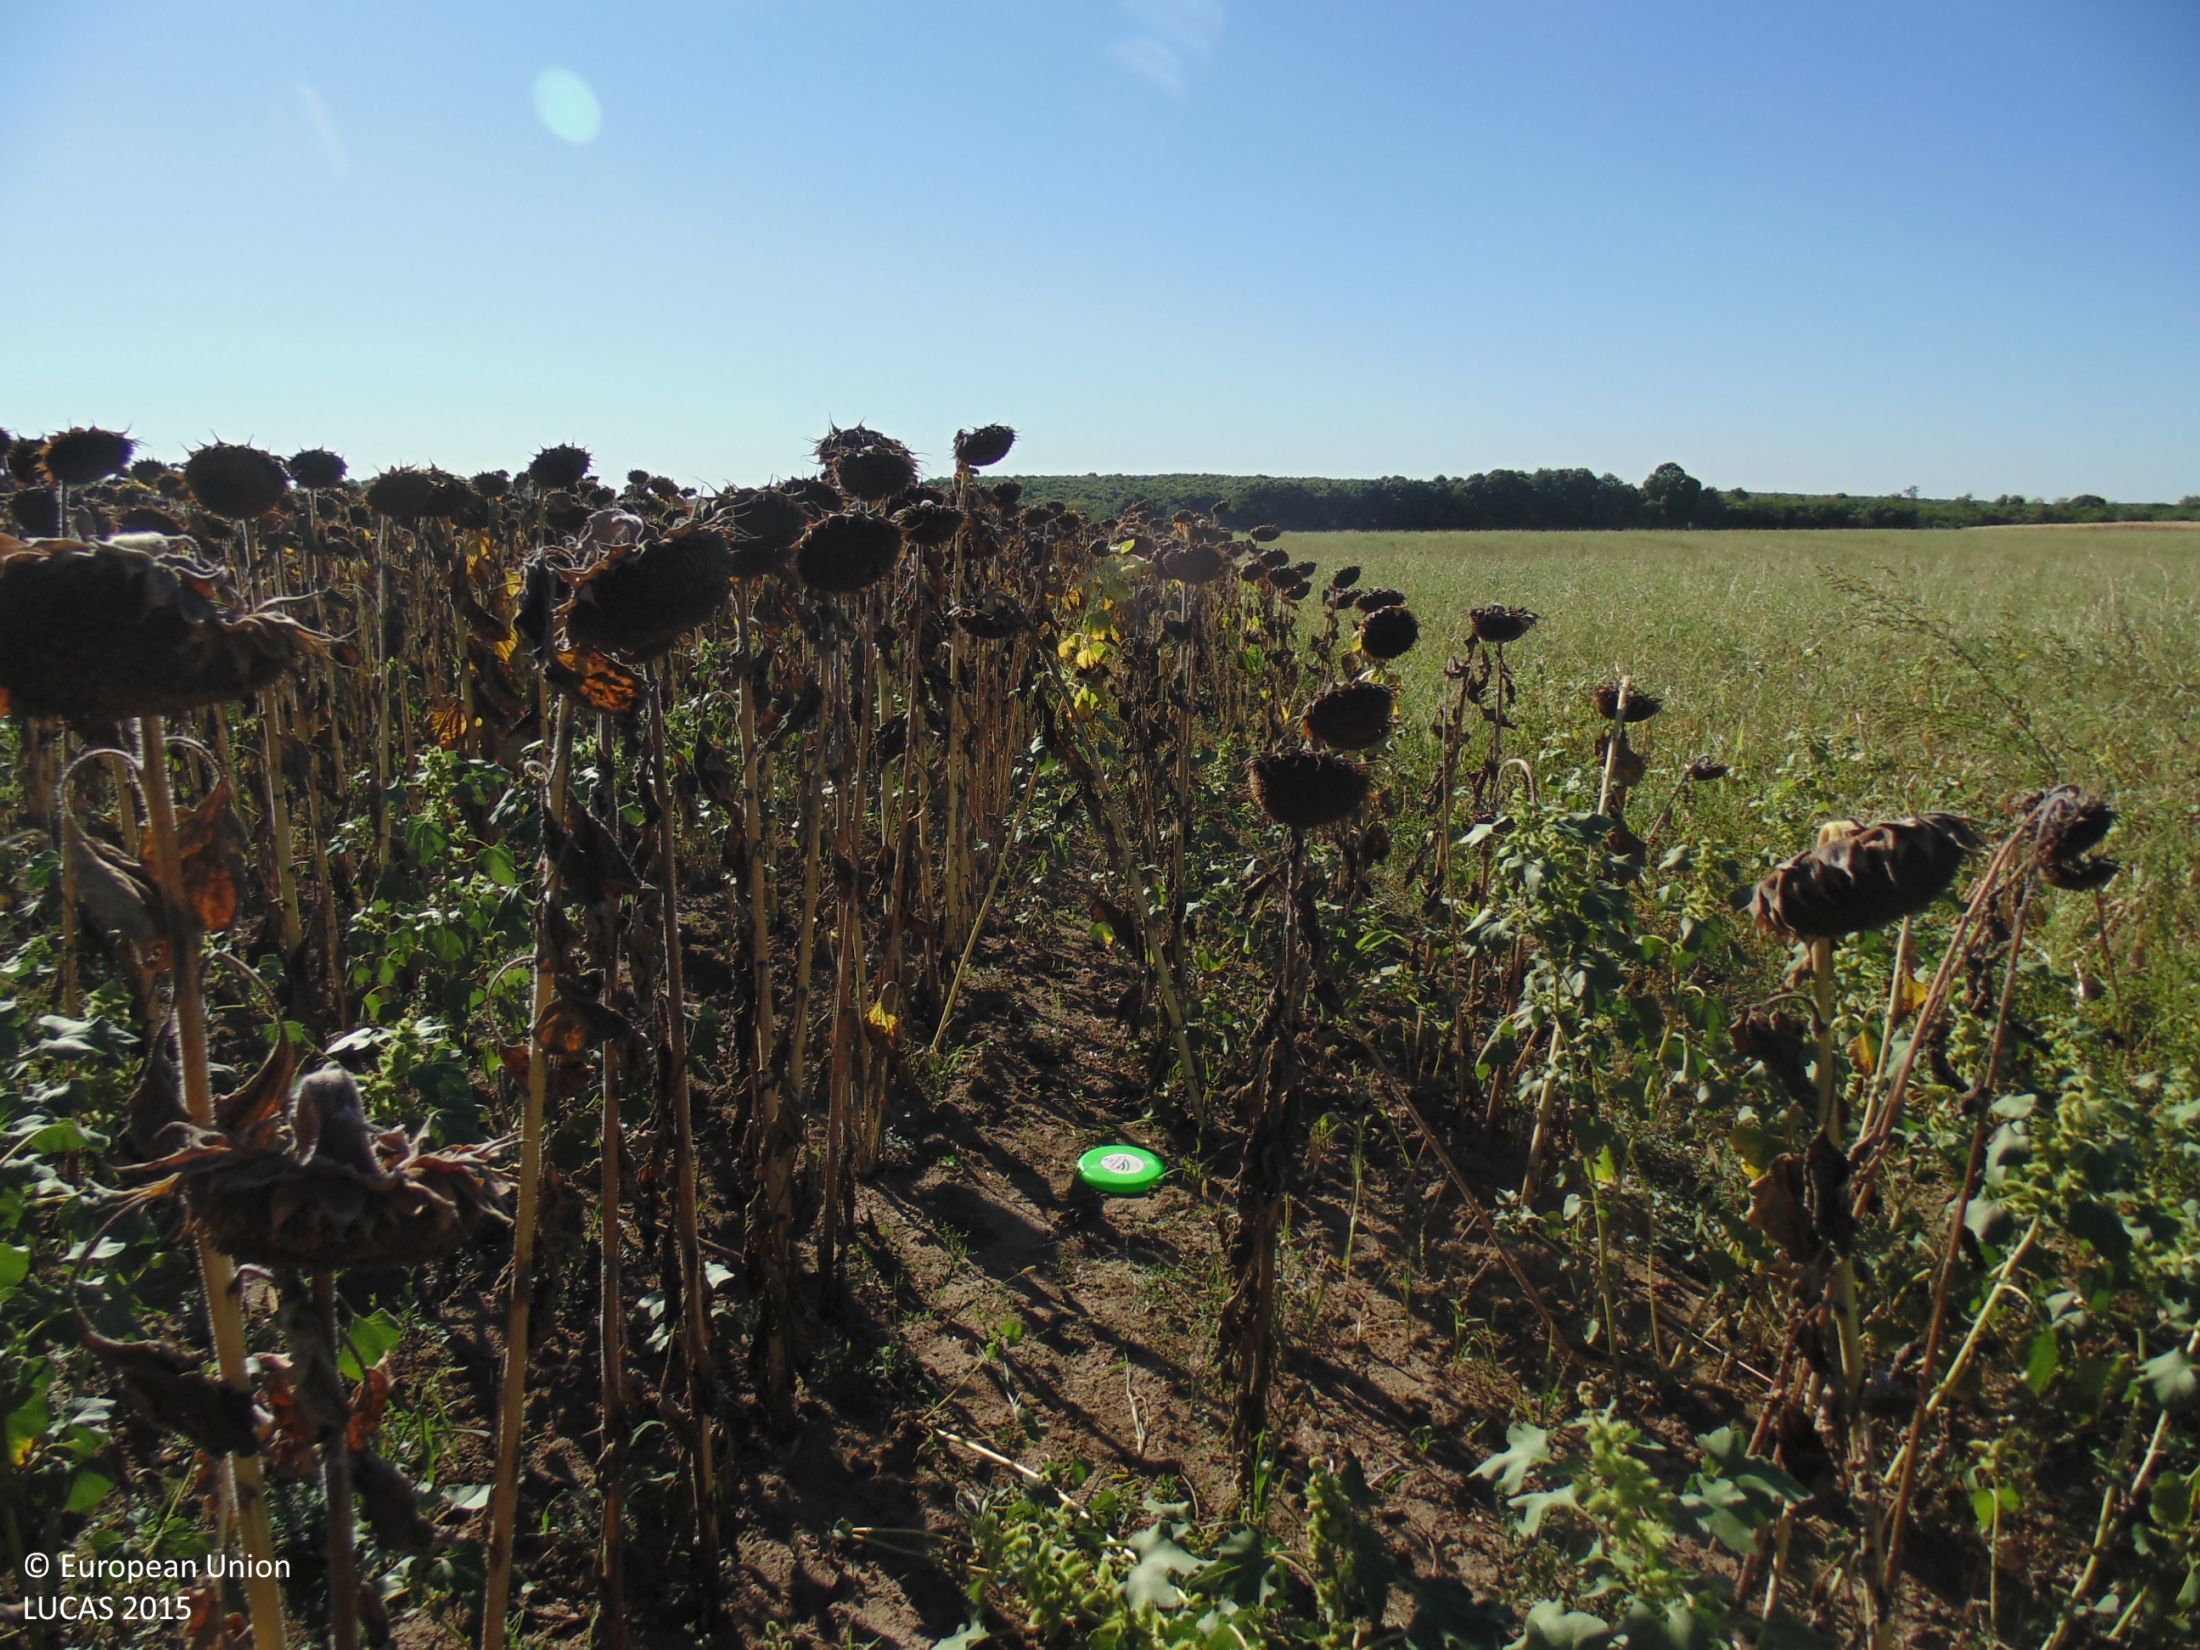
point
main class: Cropland
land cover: Sunflower
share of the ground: > 75 %
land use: Agriculture (excluding fallow land and kitchen gardens)
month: September
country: BG
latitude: 43.8570
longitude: 27.2088
